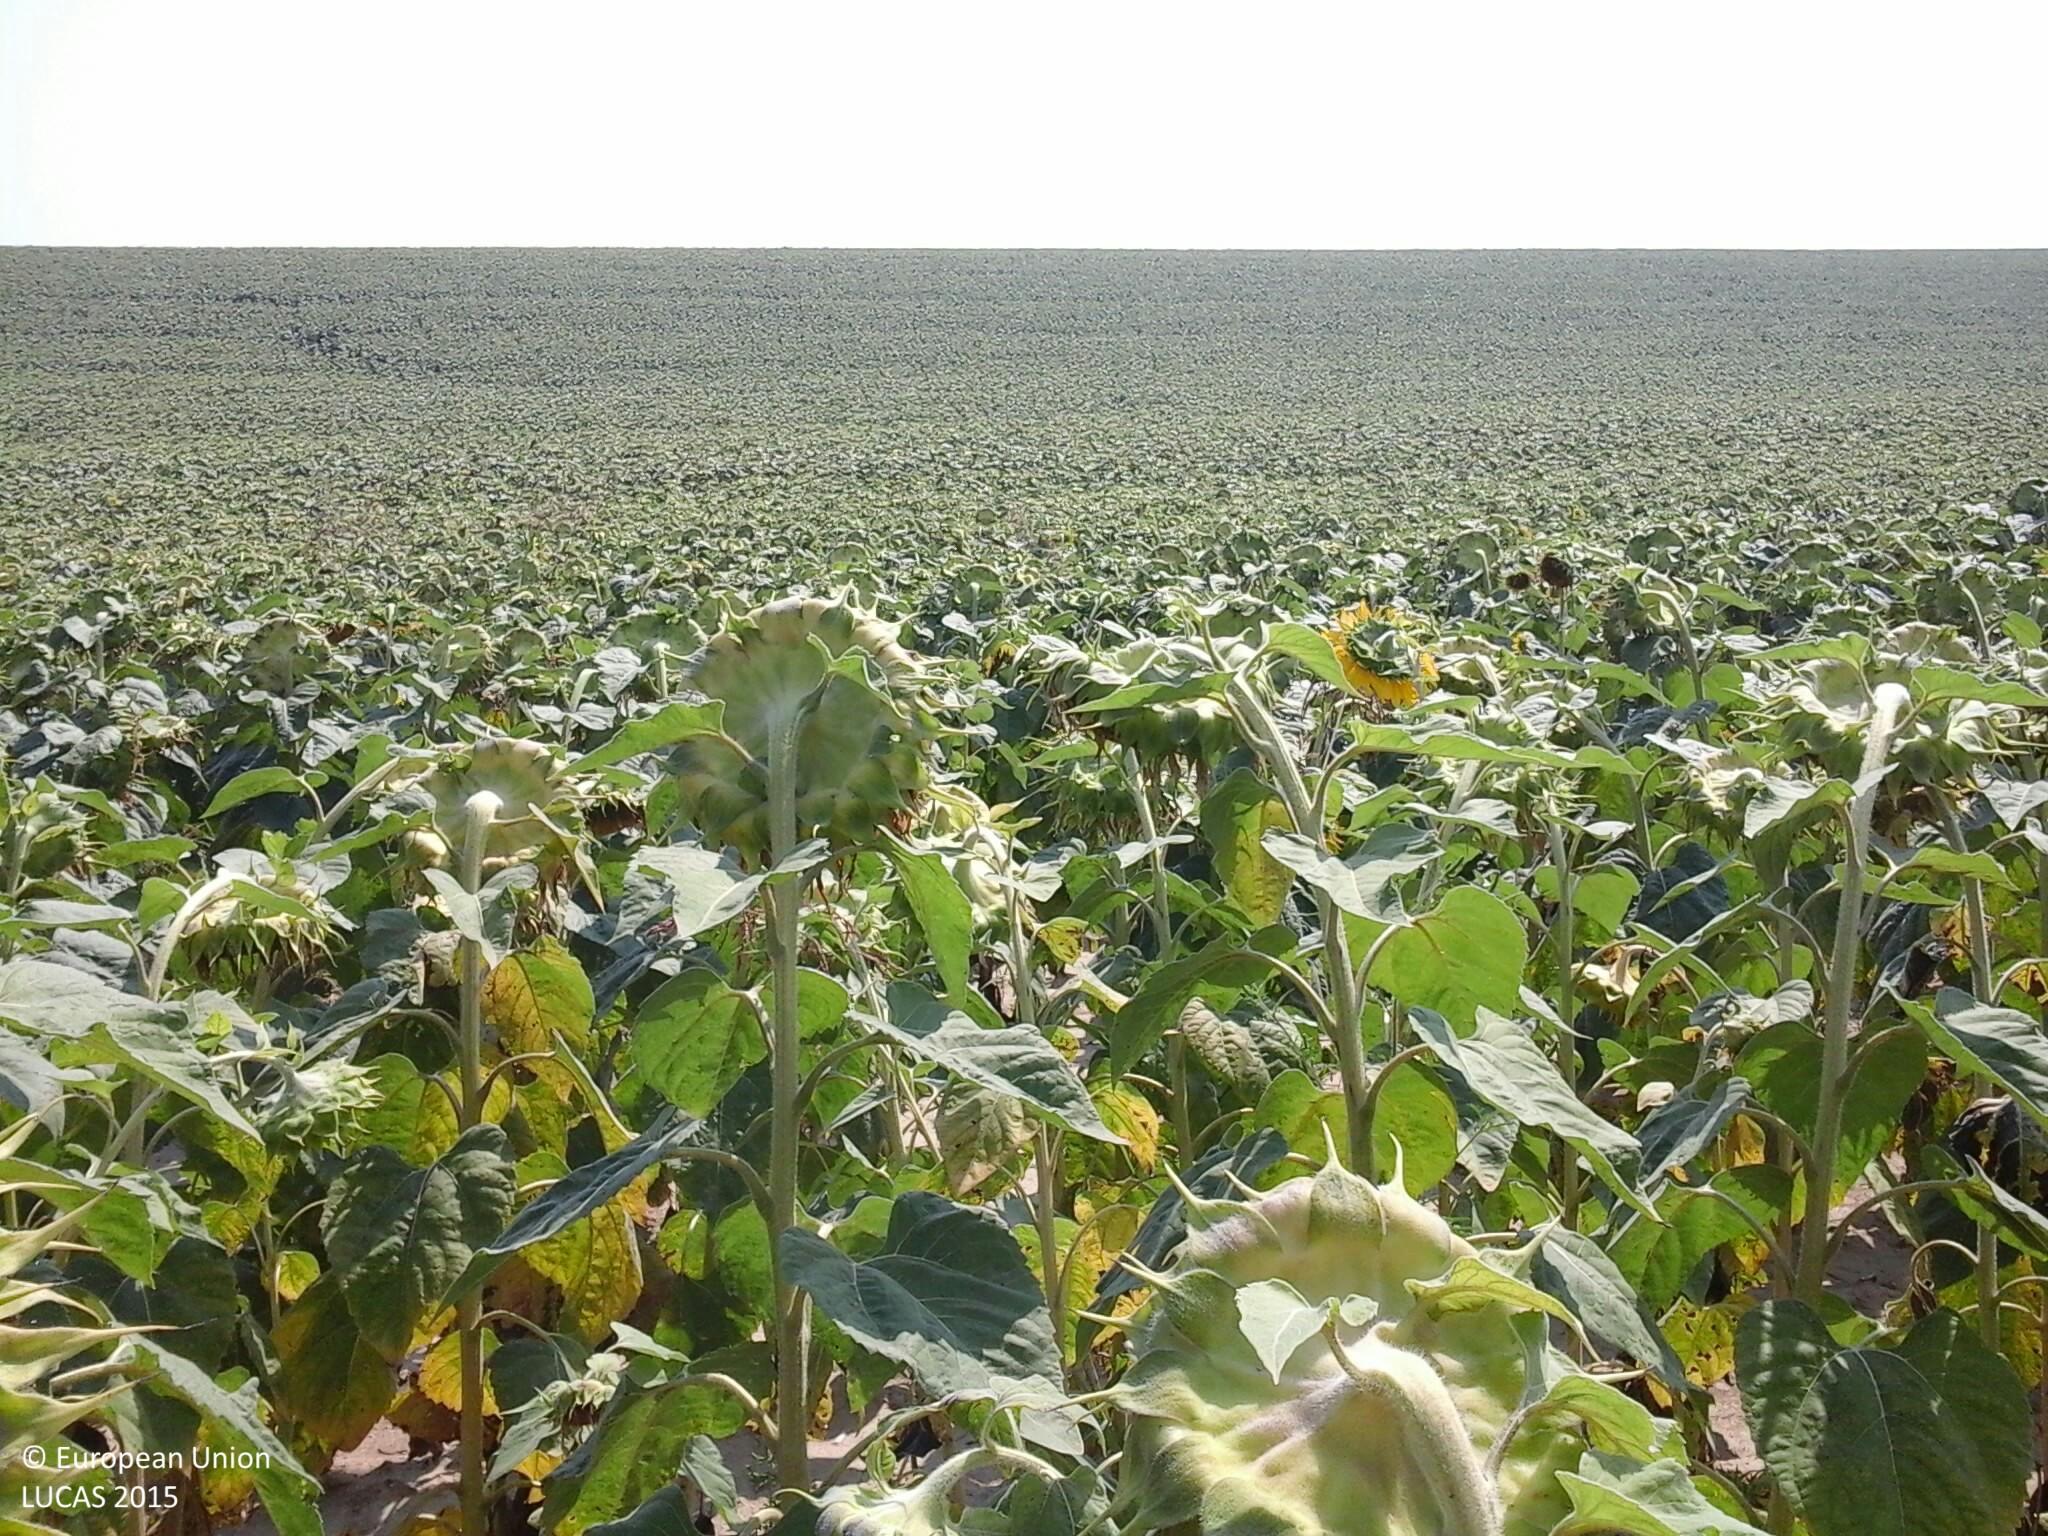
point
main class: Cropland
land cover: Sunflower
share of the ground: > 75 %
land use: Agriculture (excluding fallow land and kitchen gardens)
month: August
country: HU
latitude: 46.6529
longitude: 17.9392
